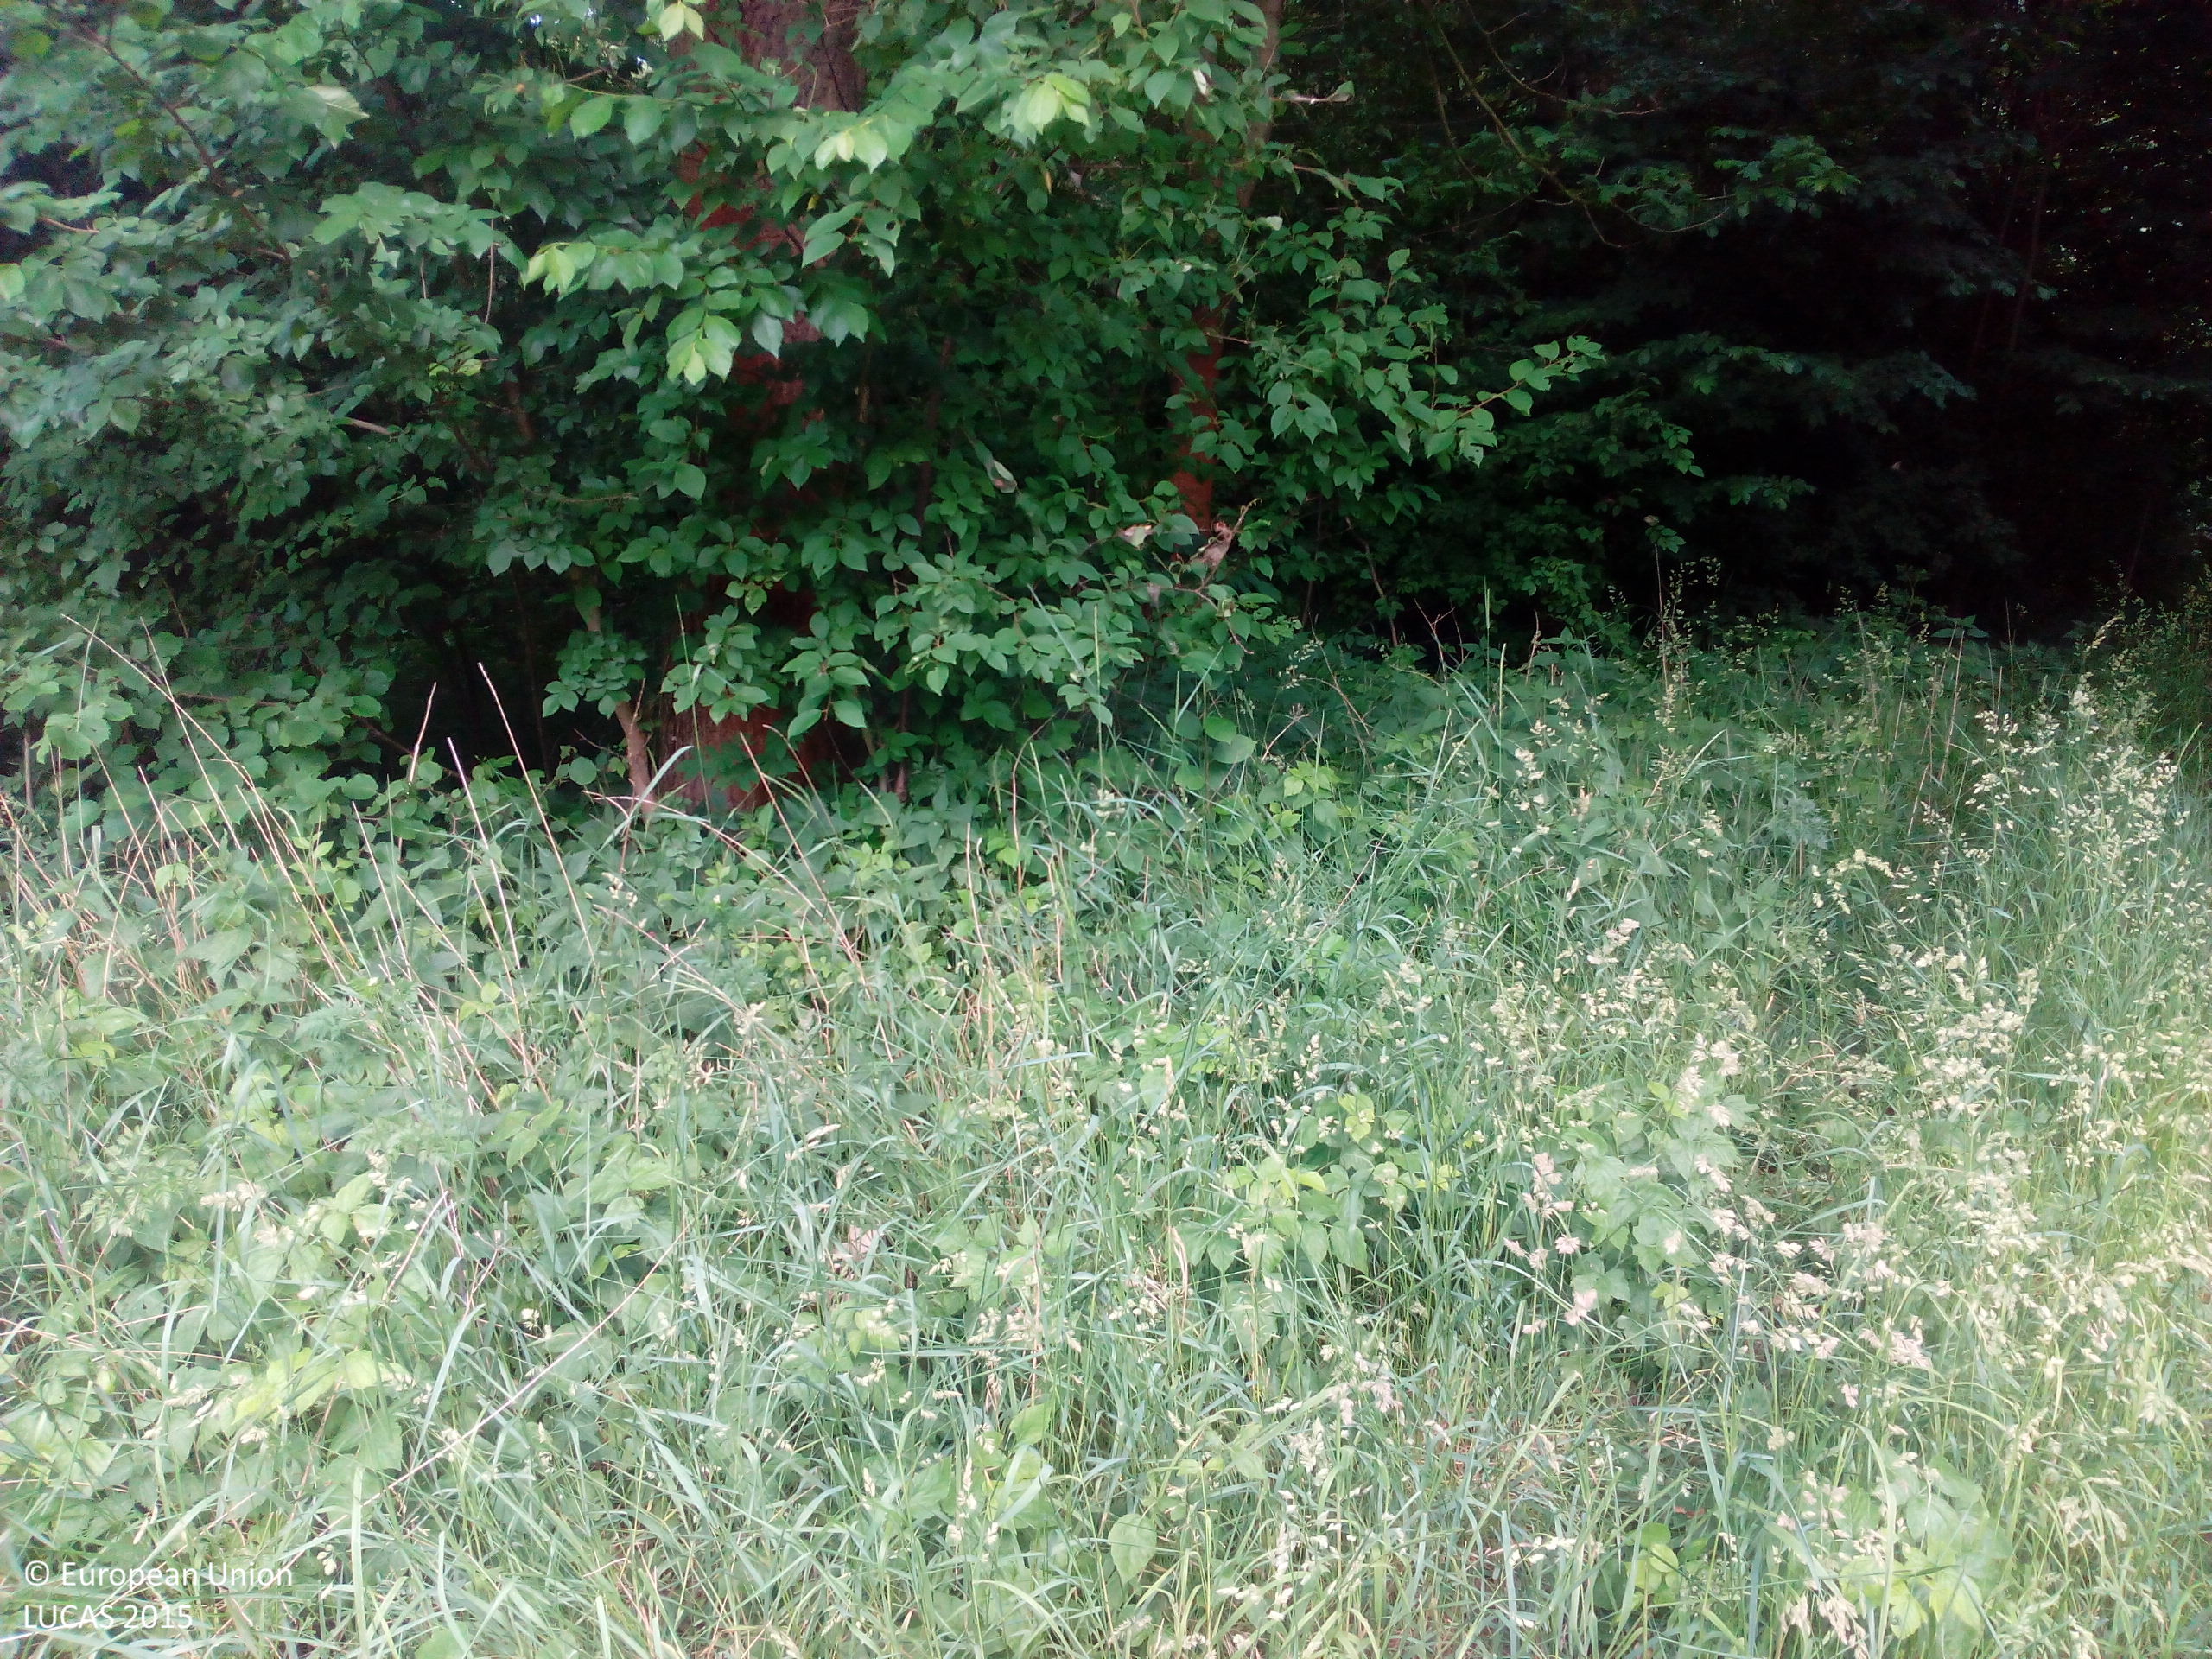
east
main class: Woodland
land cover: Broadleaved woodland
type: mesophytic deciduous forest
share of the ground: 50 - 75 %
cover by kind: broadleaved forest trees 75 %, shrubs 15 %, herbaceous plants 10 %
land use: Forestry
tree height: > 5 m
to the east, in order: Broadleaved woodland; Fences; Broadleaved woodland
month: June
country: DE
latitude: 51.3882
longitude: 12.0833
